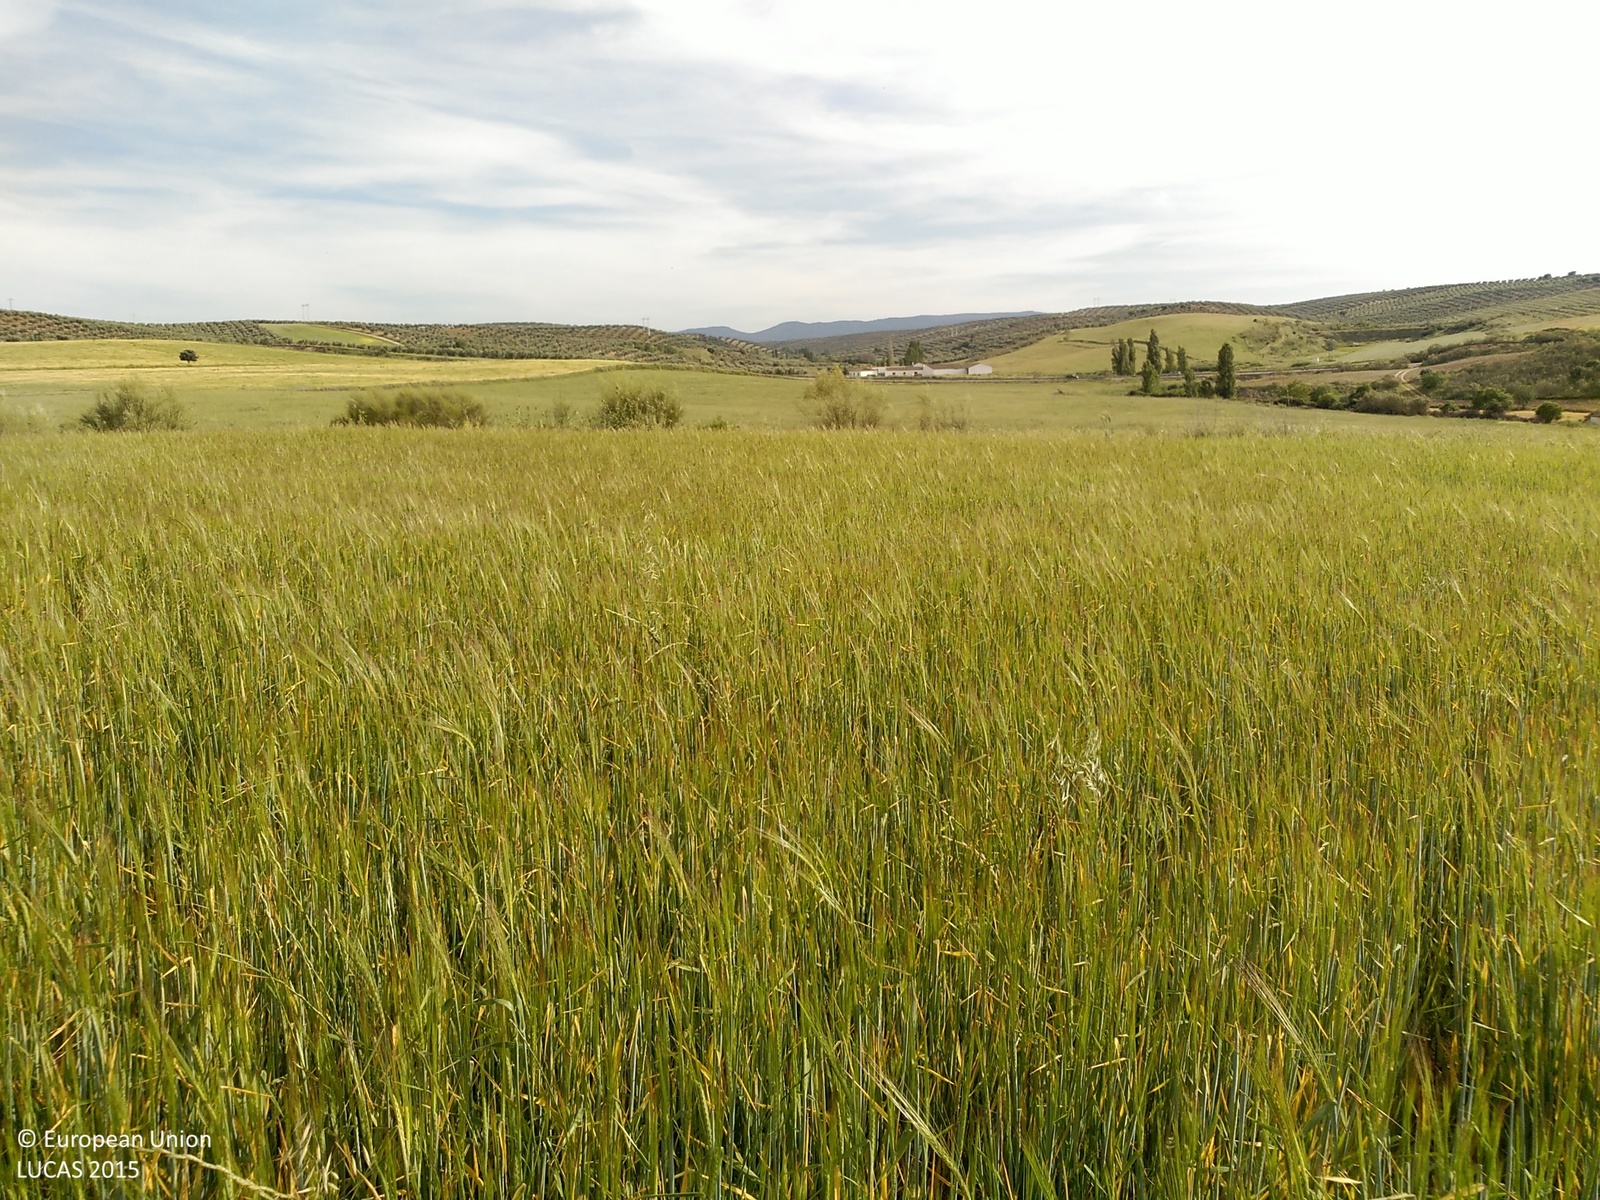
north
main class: Cropland
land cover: Barley
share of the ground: > 75 %
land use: Agriculture (excluding fallow land and kitchen gardens)
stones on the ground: < 10 %
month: May
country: ES
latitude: 39.7638
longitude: -4.6688
